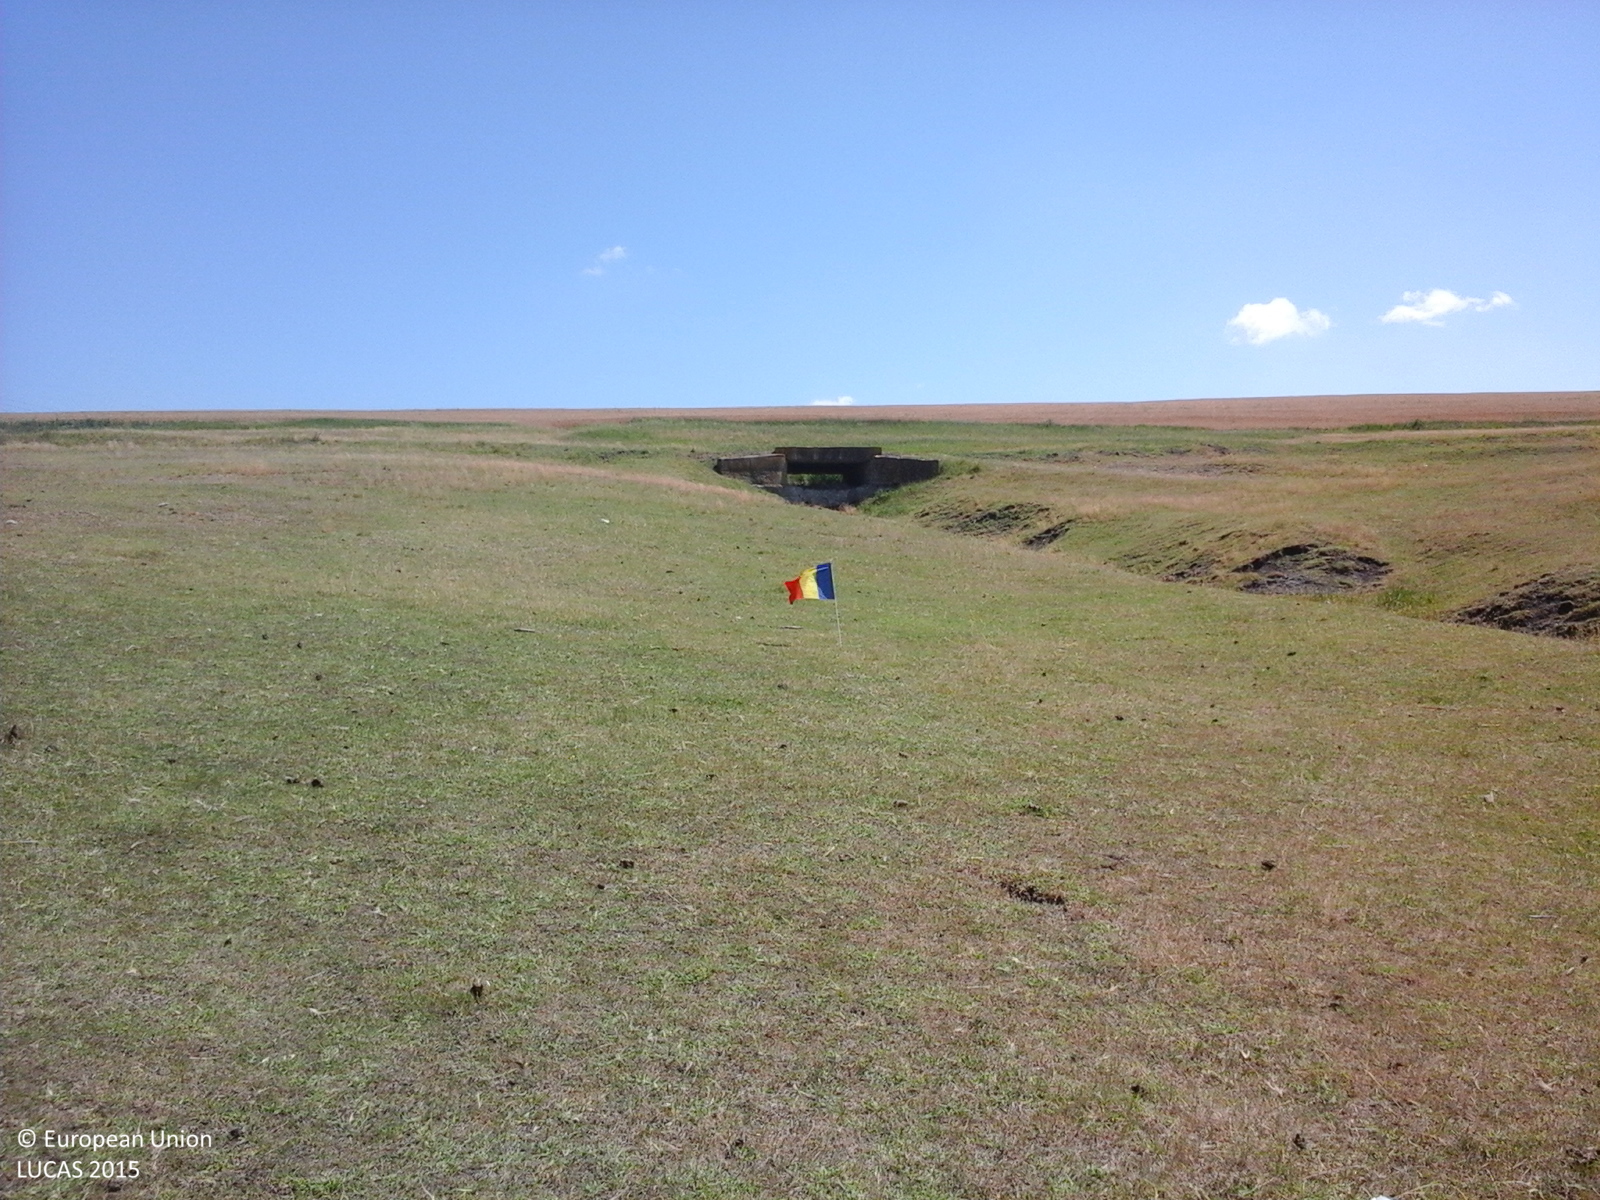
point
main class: Grassland
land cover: Grassland without tree/shrub cover
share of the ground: > 75 %
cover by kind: herbaceous plants 100 %
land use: Agriculture (excluding fallow land and kitchen gardens)
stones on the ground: 10 - 25 %
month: June
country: RO
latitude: 47.2440
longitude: 26.9713
